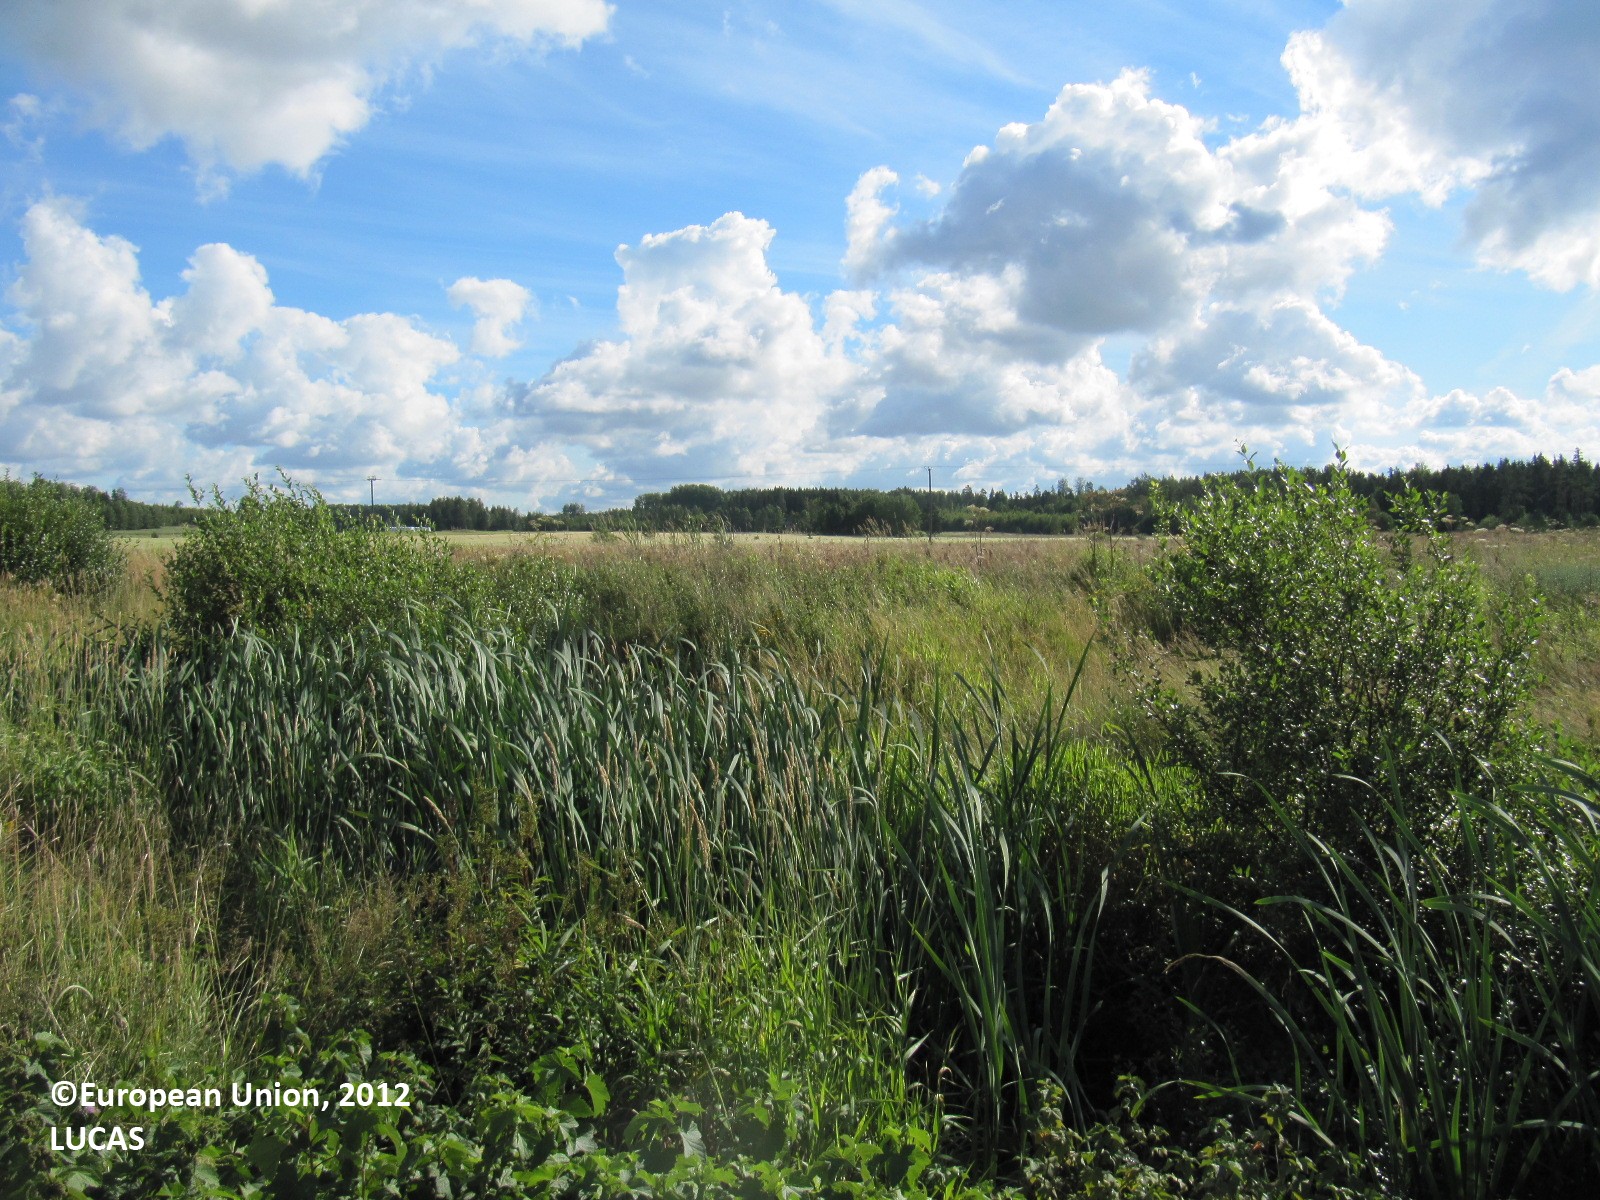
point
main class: Grassland
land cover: Spontaneously vegetated surfaces
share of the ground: > 75 %
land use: Fallow land
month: August
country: FI
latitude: 60.4751
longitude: 23.1606
